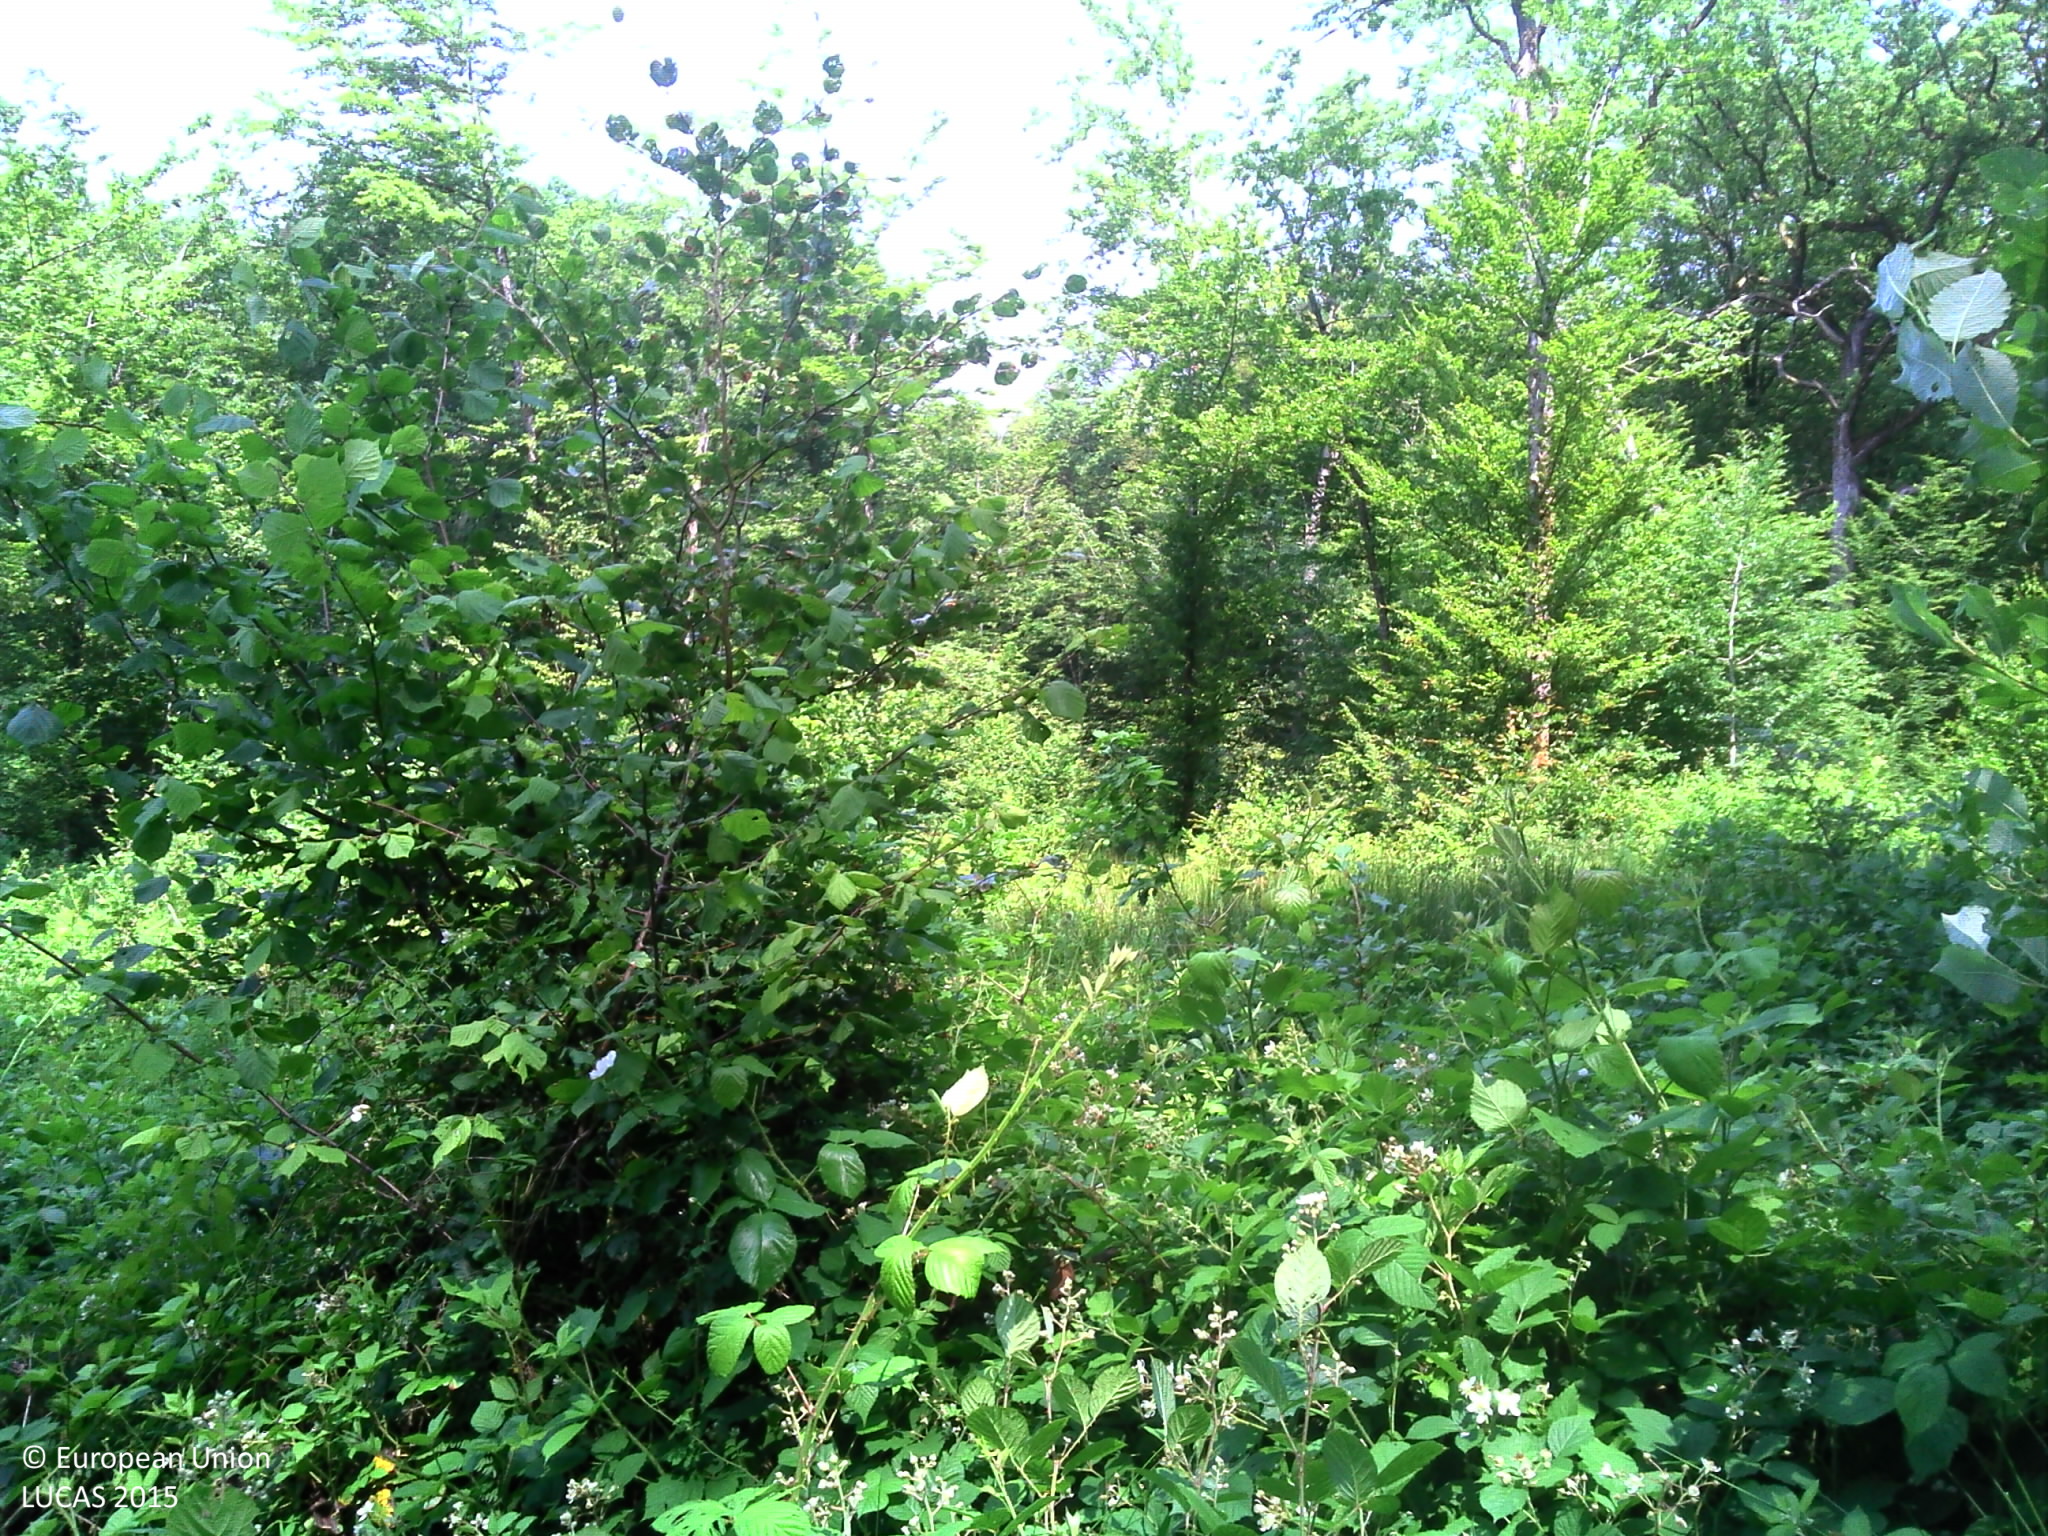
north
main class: Shrubland
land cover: Shrubland without tree cover
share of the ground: > 75 %
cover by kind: shrubs 95 %, herbaceous plants 5 %
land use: Forestry
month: June
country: FR
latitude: 47.8543
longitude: 6.2721
